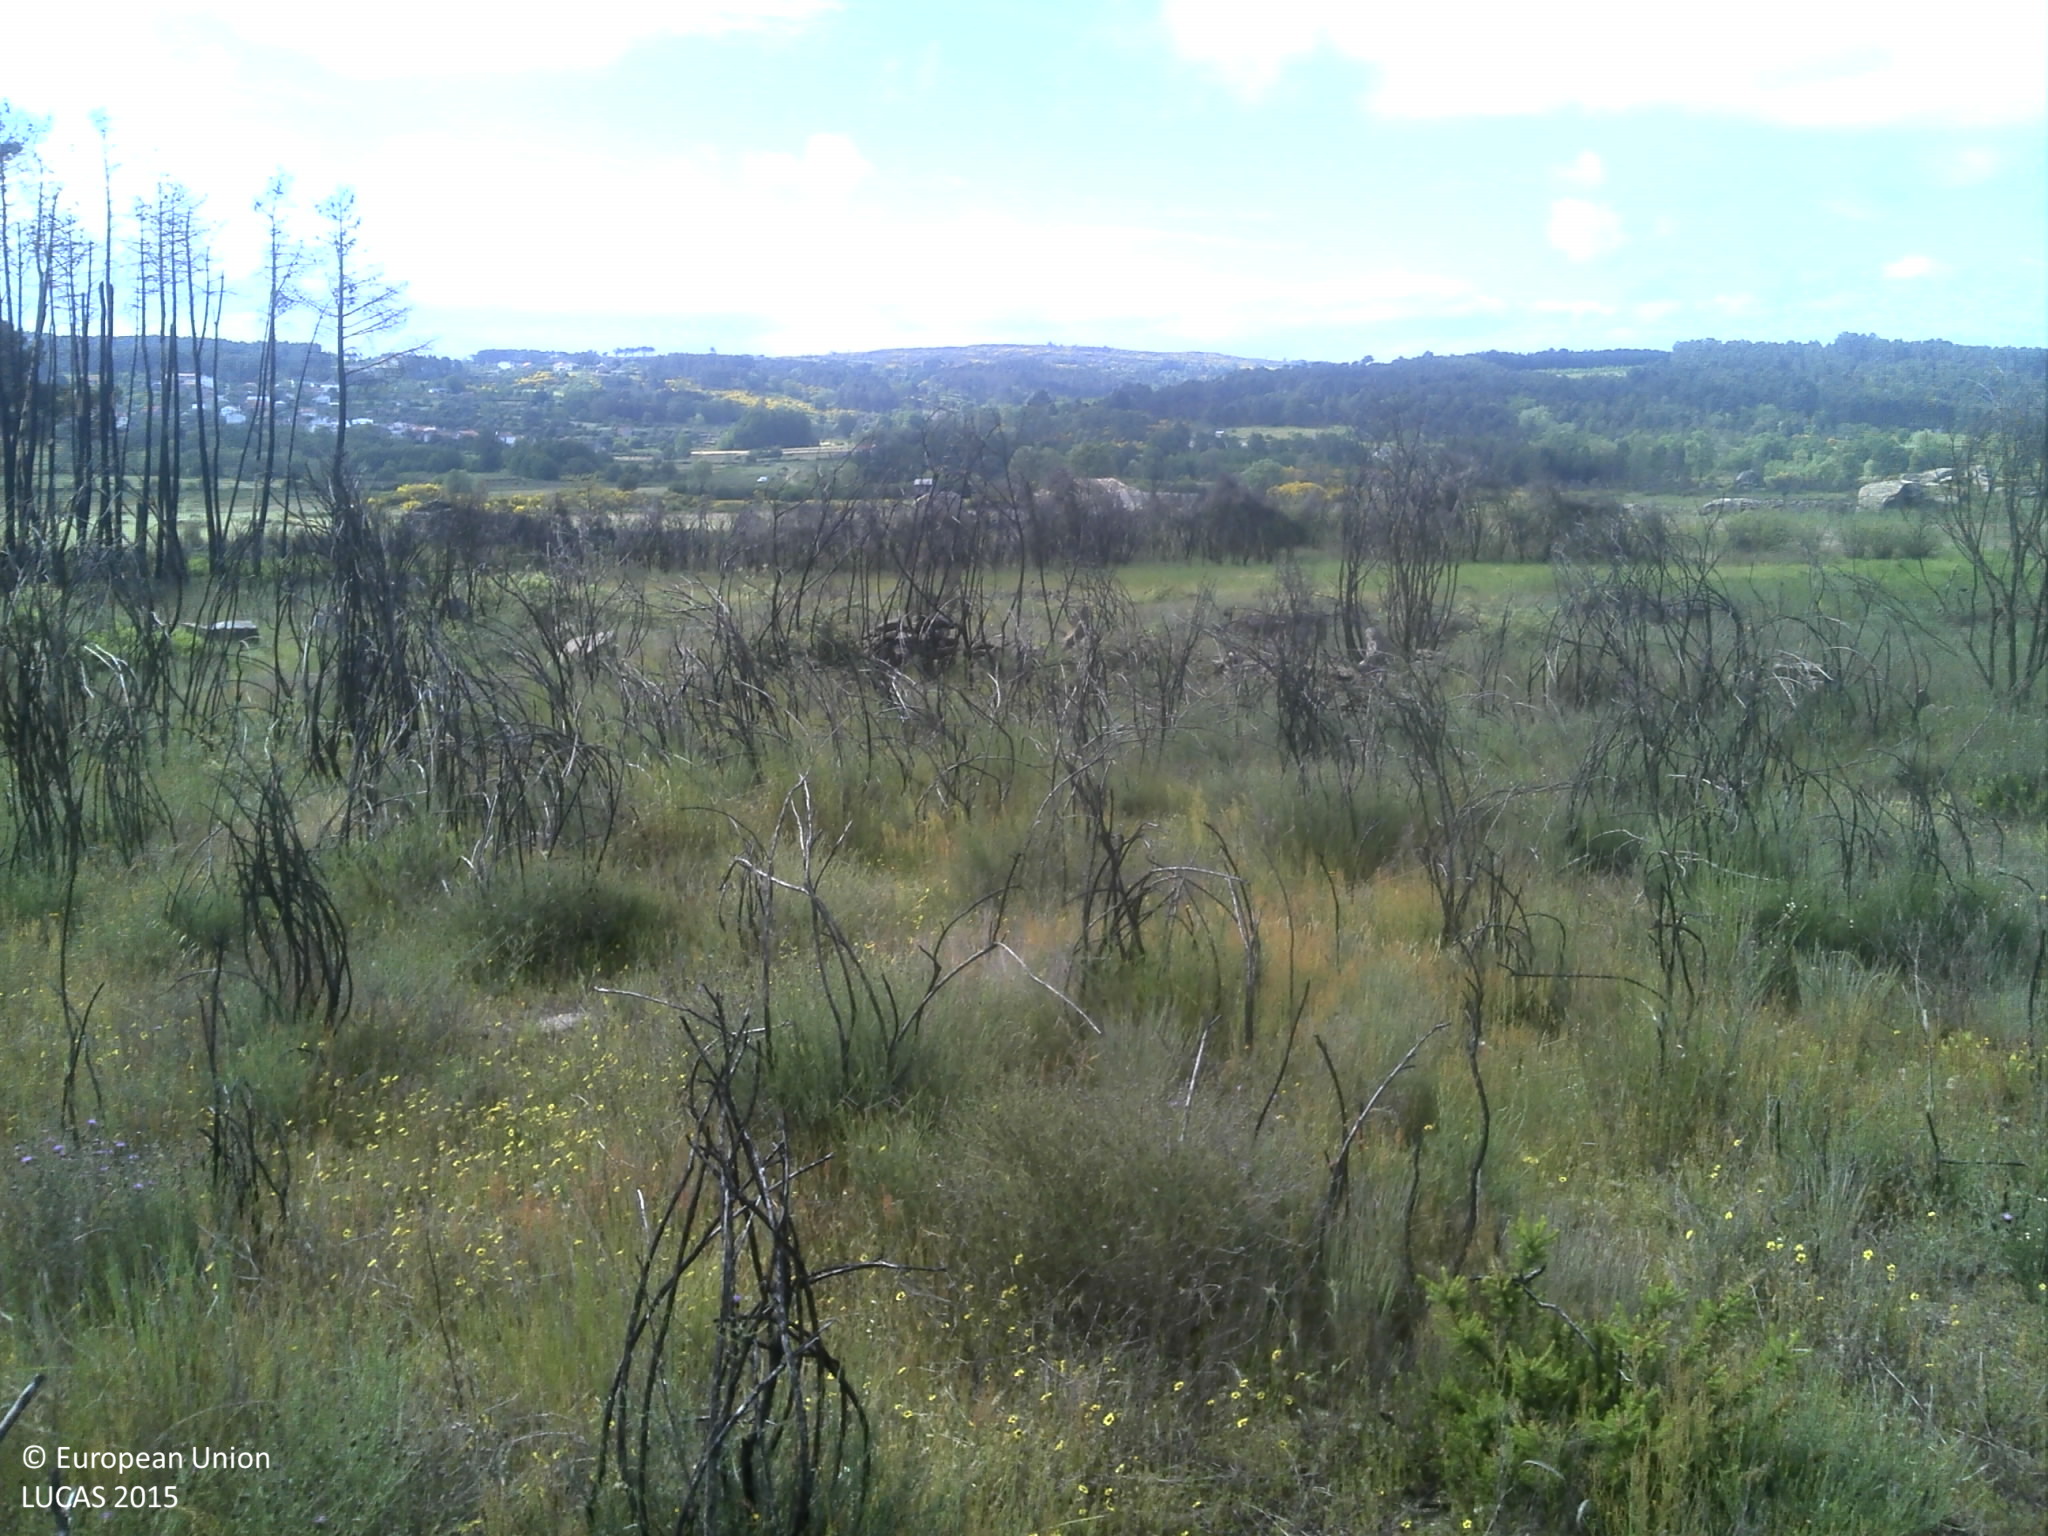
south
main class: Shrubland
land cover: Shrubland without tree cover
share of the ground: 25 - 50 %
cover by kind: shrubs 45 %, herbaceous plants 30 %, unconsolidated bare surface 20 %
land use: Abandoned areas
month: May
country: PT
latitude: 40.6668
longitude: -7.5391
